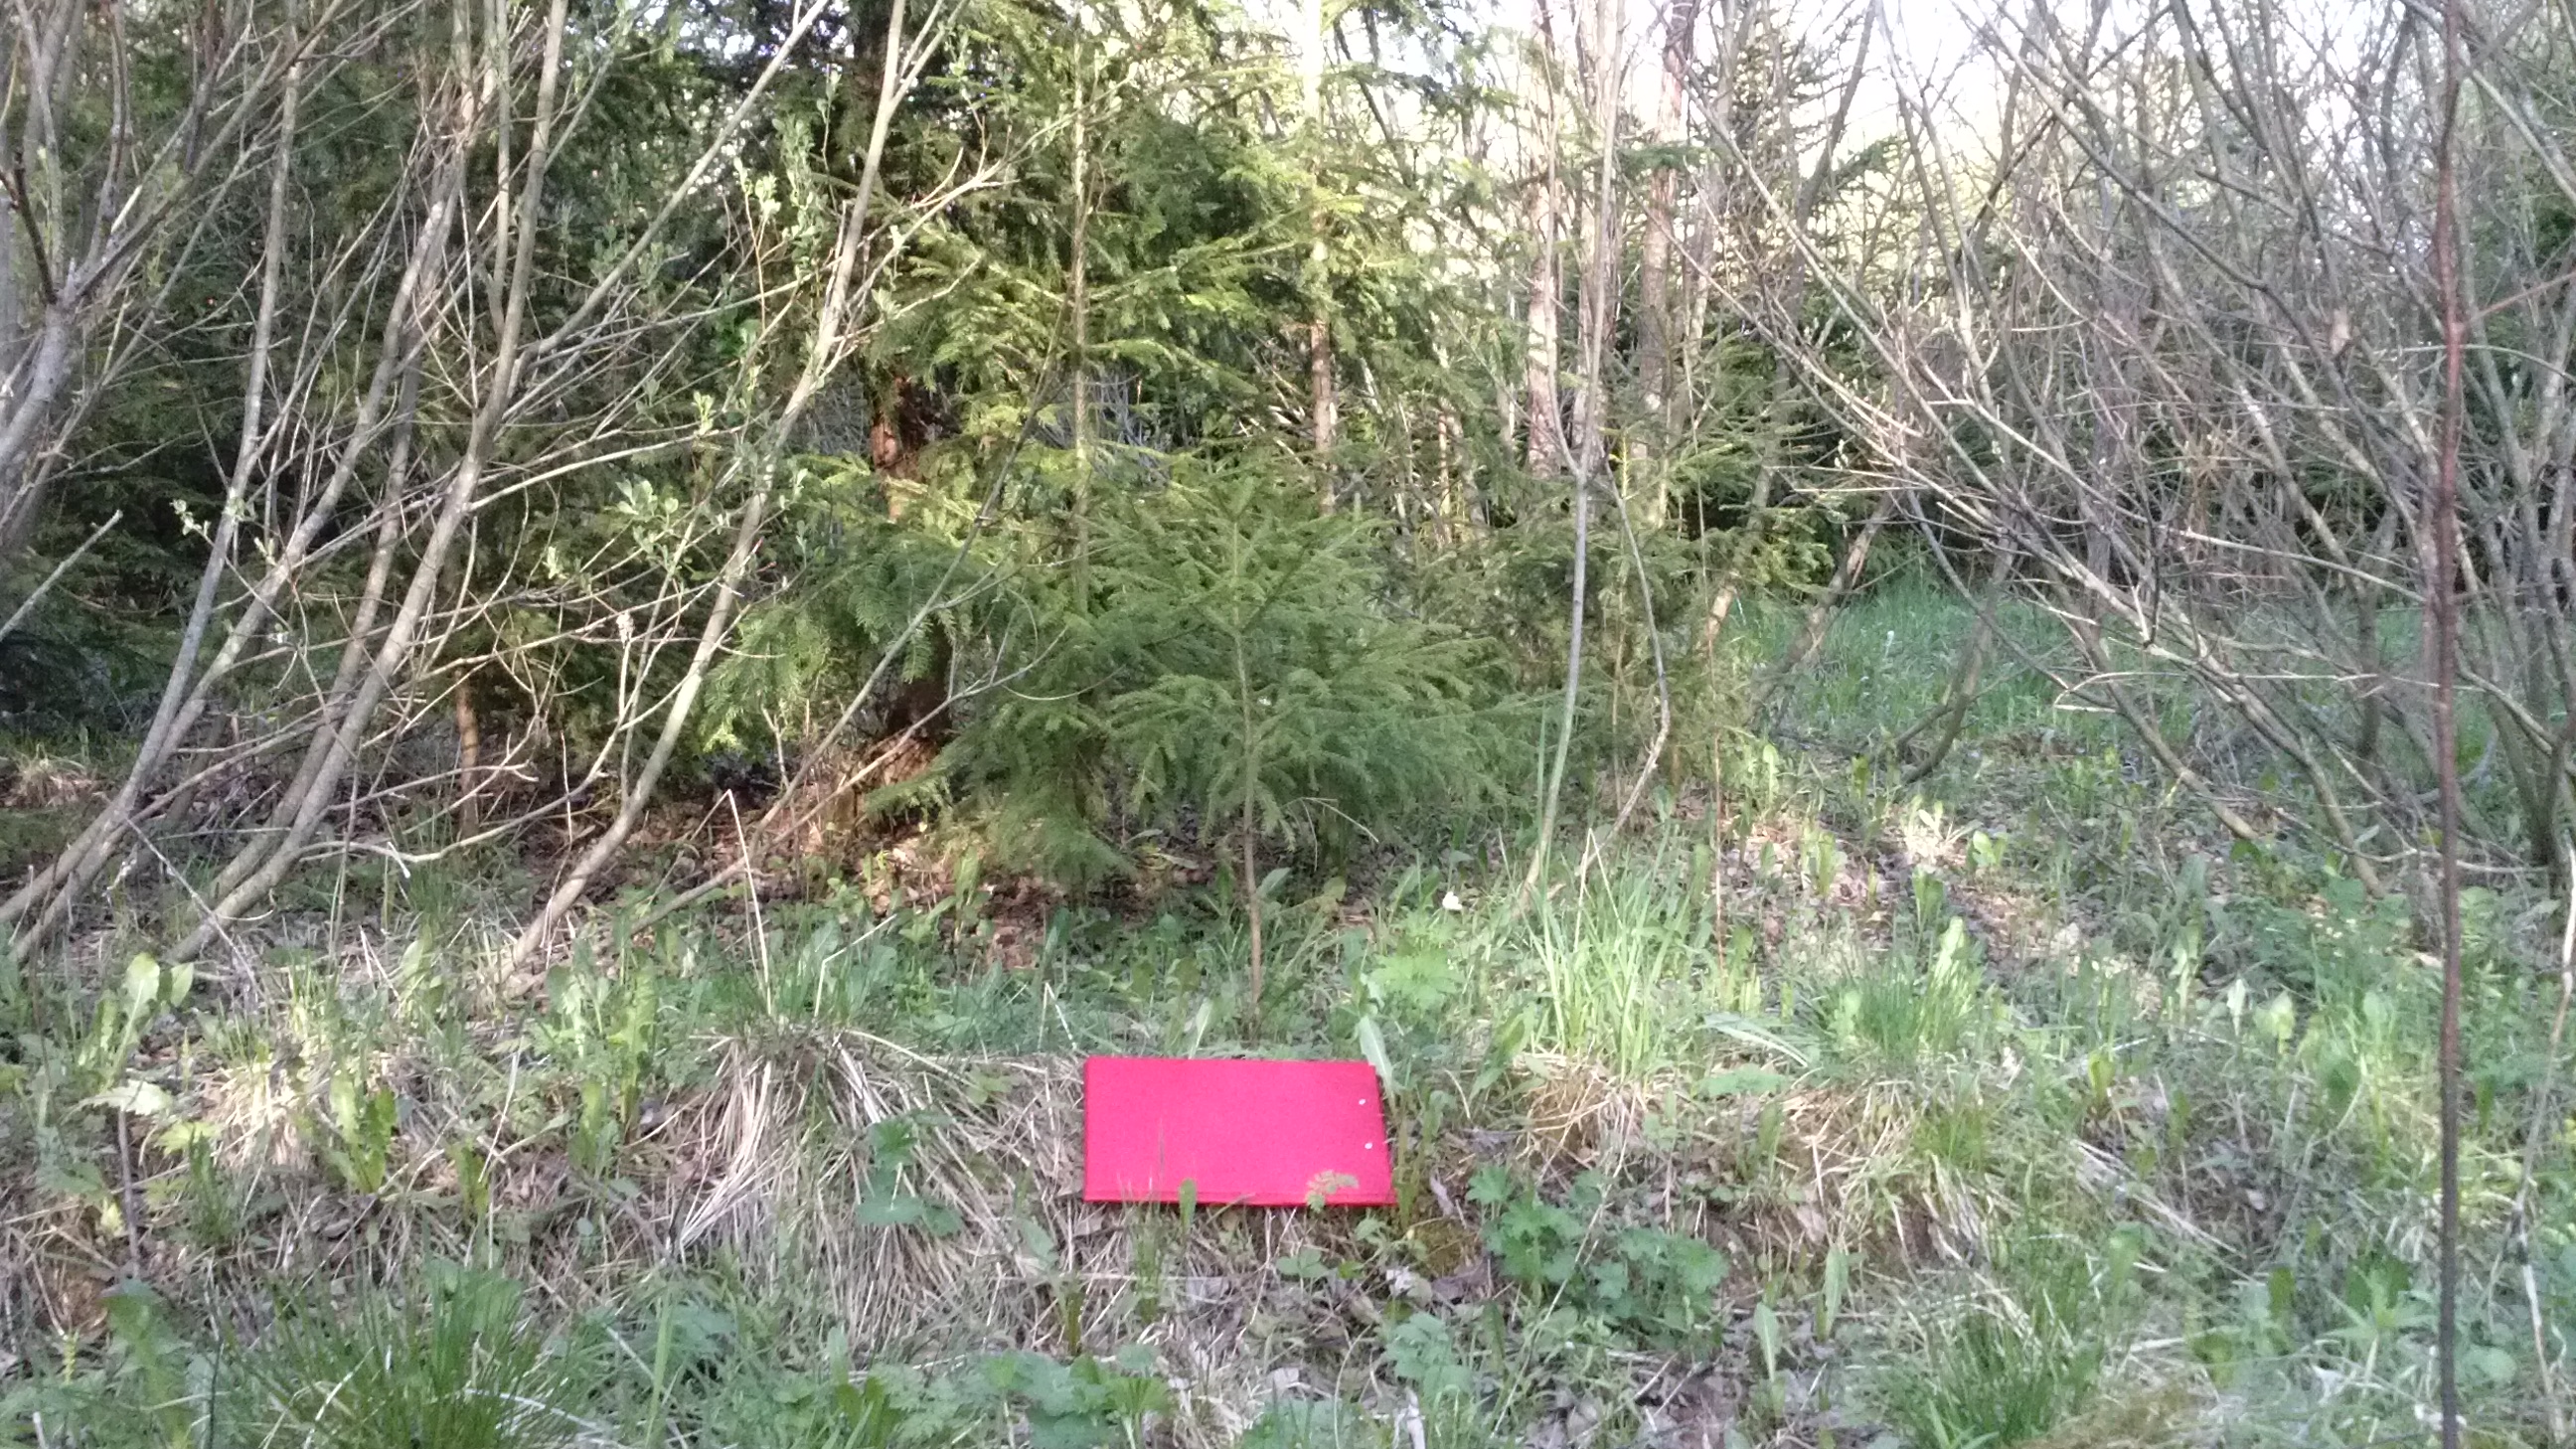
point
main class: Woodland
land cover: Spruce dominated mixed woodland
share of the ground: > 75 %
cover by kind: coniferous forest trees 75 %, broadleaved forest trees 25 %
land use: Forestry
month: May
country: LV
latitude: 56.0926
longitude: 27.2591
